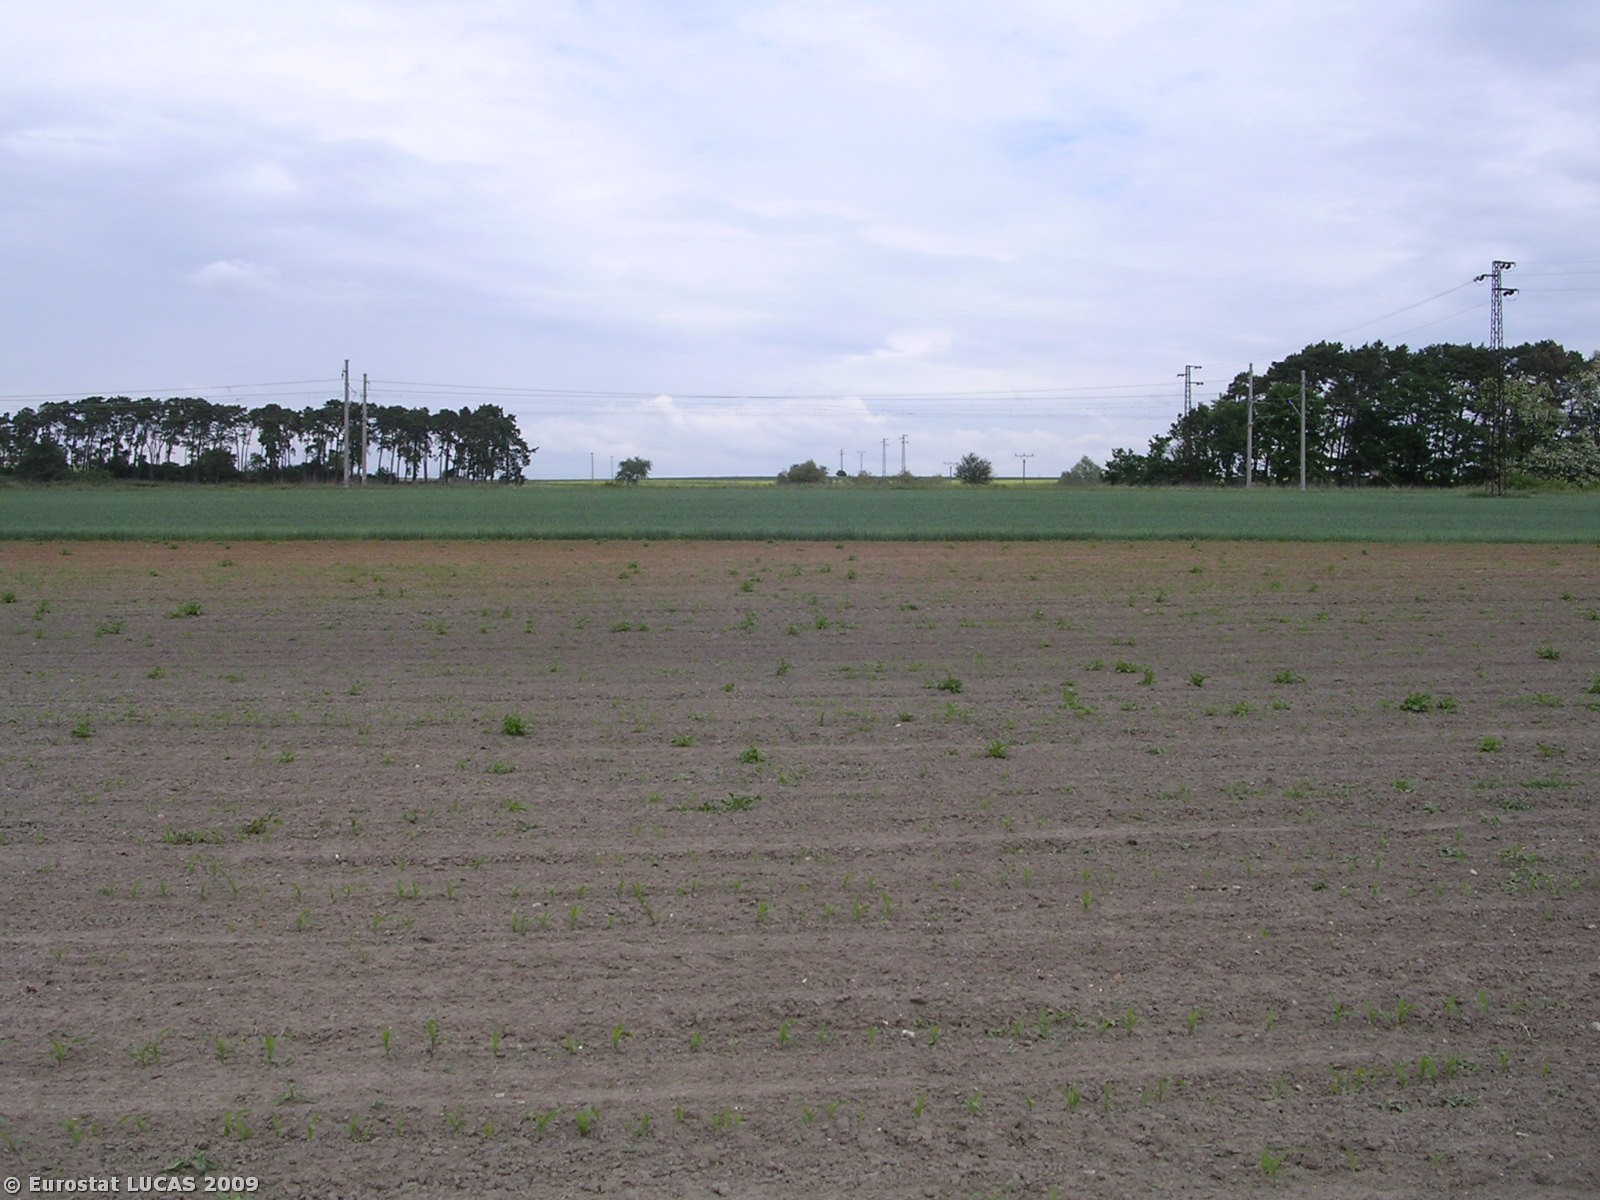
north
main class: Cropland
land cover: Maize
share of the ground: < 10 %
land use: Agriculture (excluding fallow land and kitchen gardens)
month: May
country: CZ
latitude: 50.1863
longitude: 14.9185
